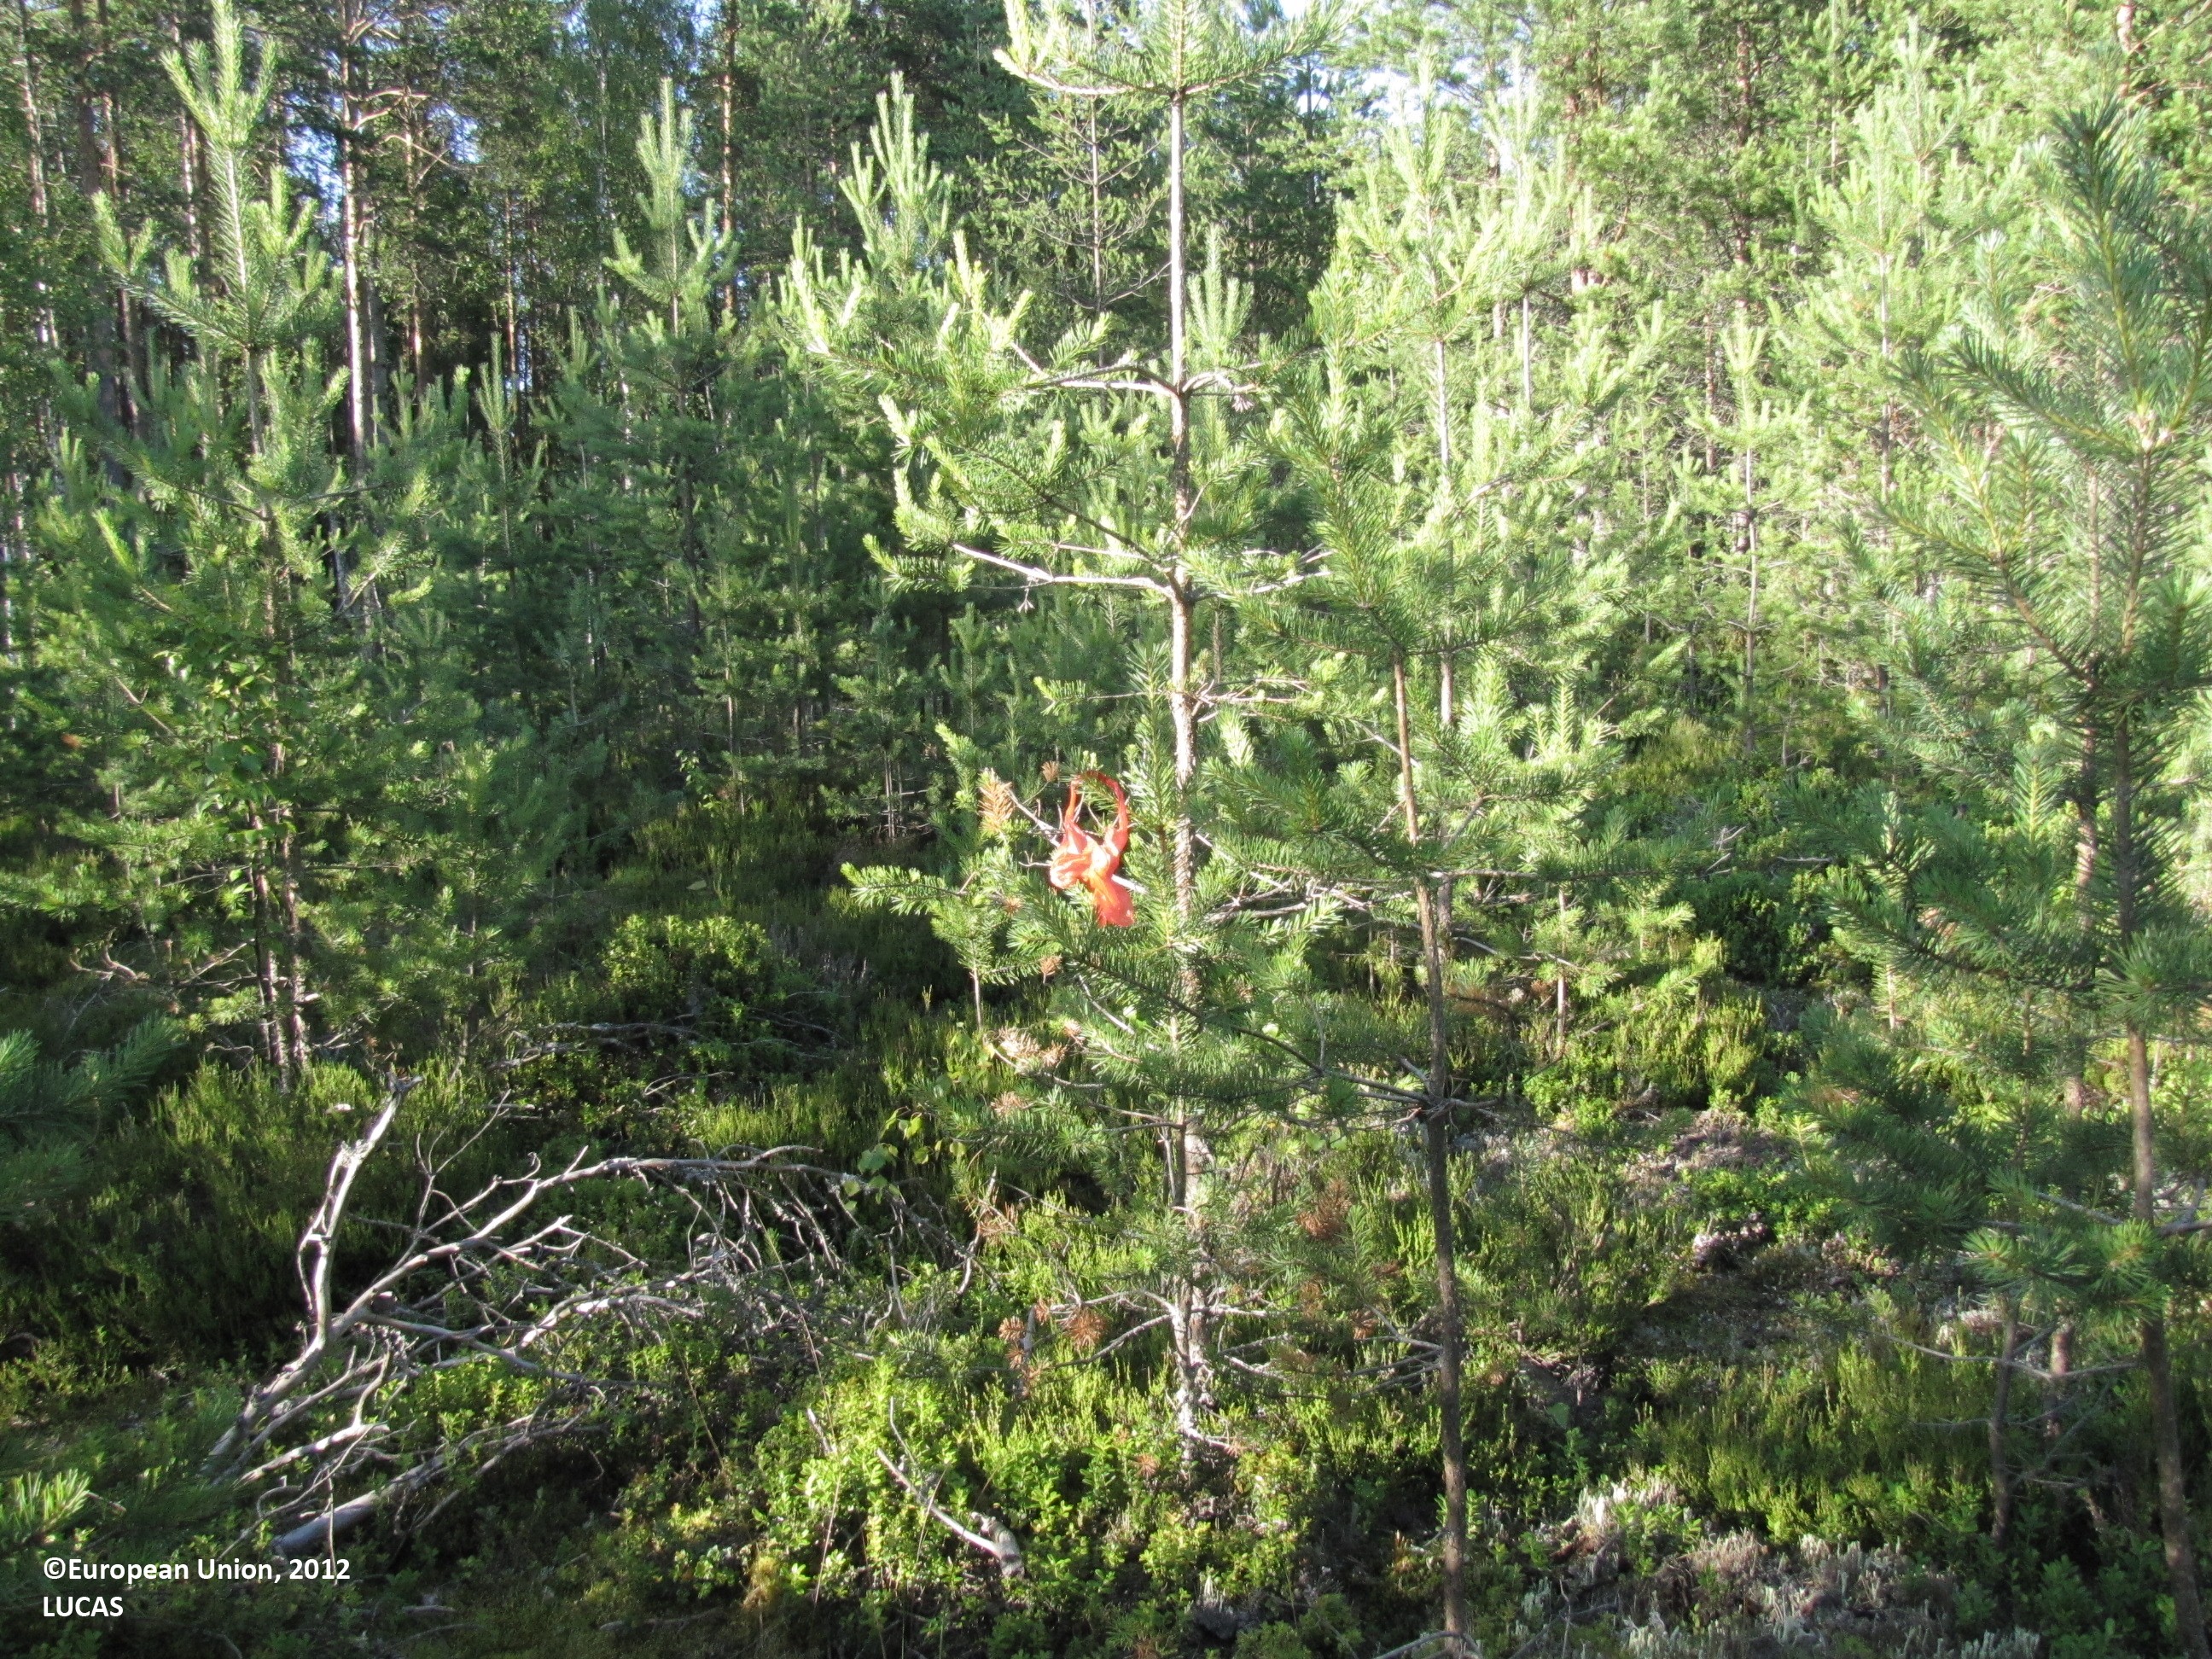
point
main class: Woodland
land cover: Pine dominated coniferous woodland
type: boreal forest
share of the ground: 25 - 50 %
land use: Forestry
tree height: > 5 m
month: July
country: FI
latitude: 62.5213
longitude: 23.2179
